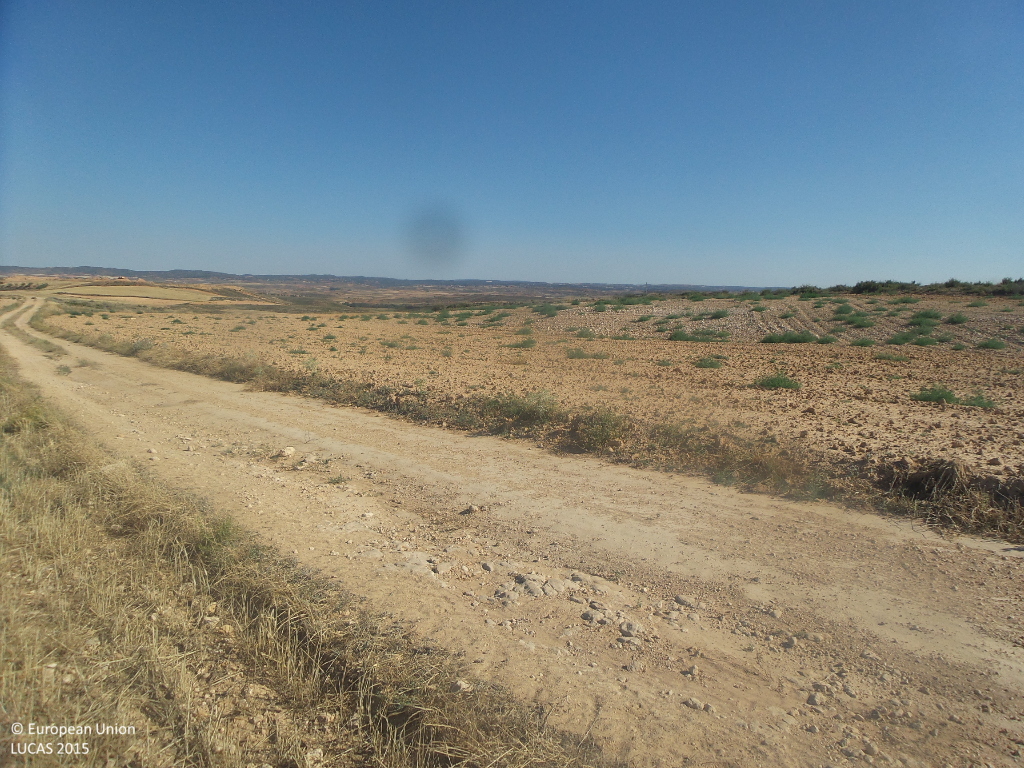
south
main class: Cropland
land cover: Barley
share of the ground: < 10 %
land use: Agriculture (excluding fallow land and kitchen gardens)
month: July
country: ES
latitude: 41.3192
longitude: -1.9864
